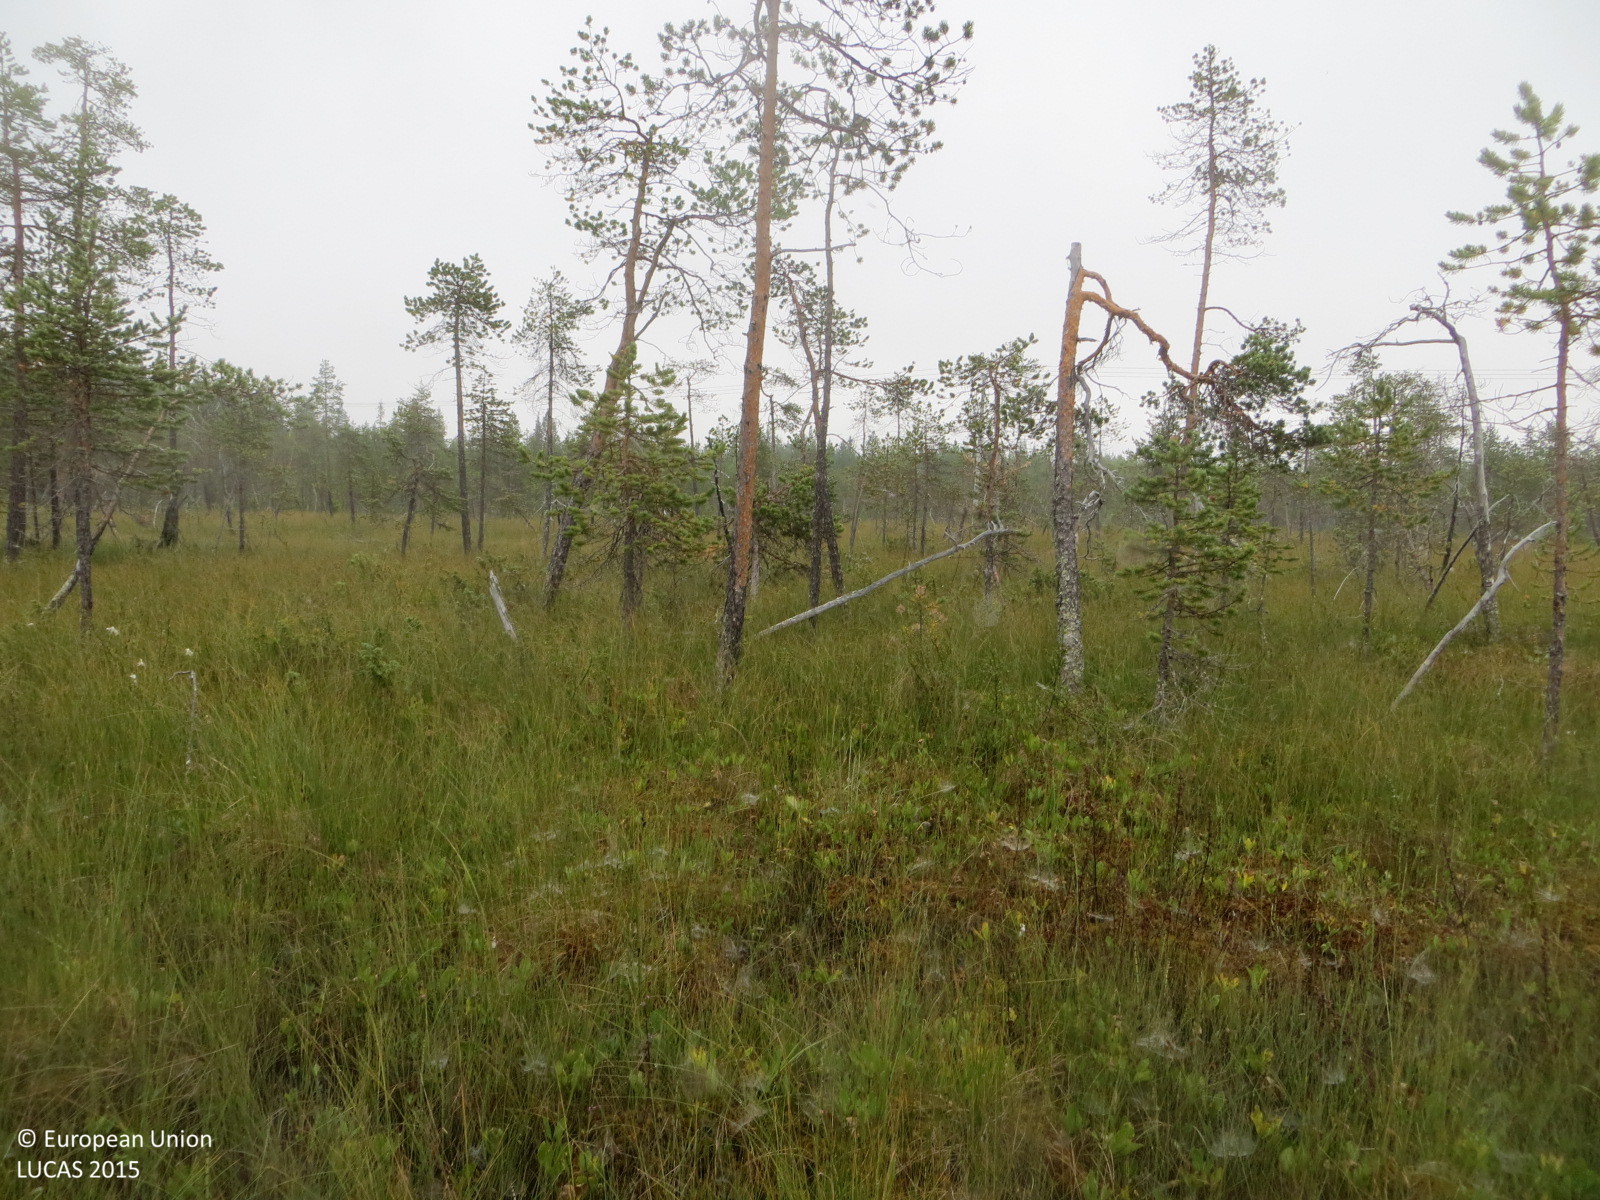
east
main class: Woodland
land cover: Pine dominated coniferous woodland
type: mire and swamp forests
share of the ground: 10 - 25 %
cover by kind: herbaceous plants 70 %, coniferous forest trees 15 %, shrubs 15 %
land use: Semi-natural and natural areas not in use
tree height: > 5 m
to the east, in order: Pine dominated coniferous woodland; Electric lines; Pine dominated coniferous woodland; Other mixed woodland
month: August
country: FI
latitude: 67.3712
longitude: 23.9752
